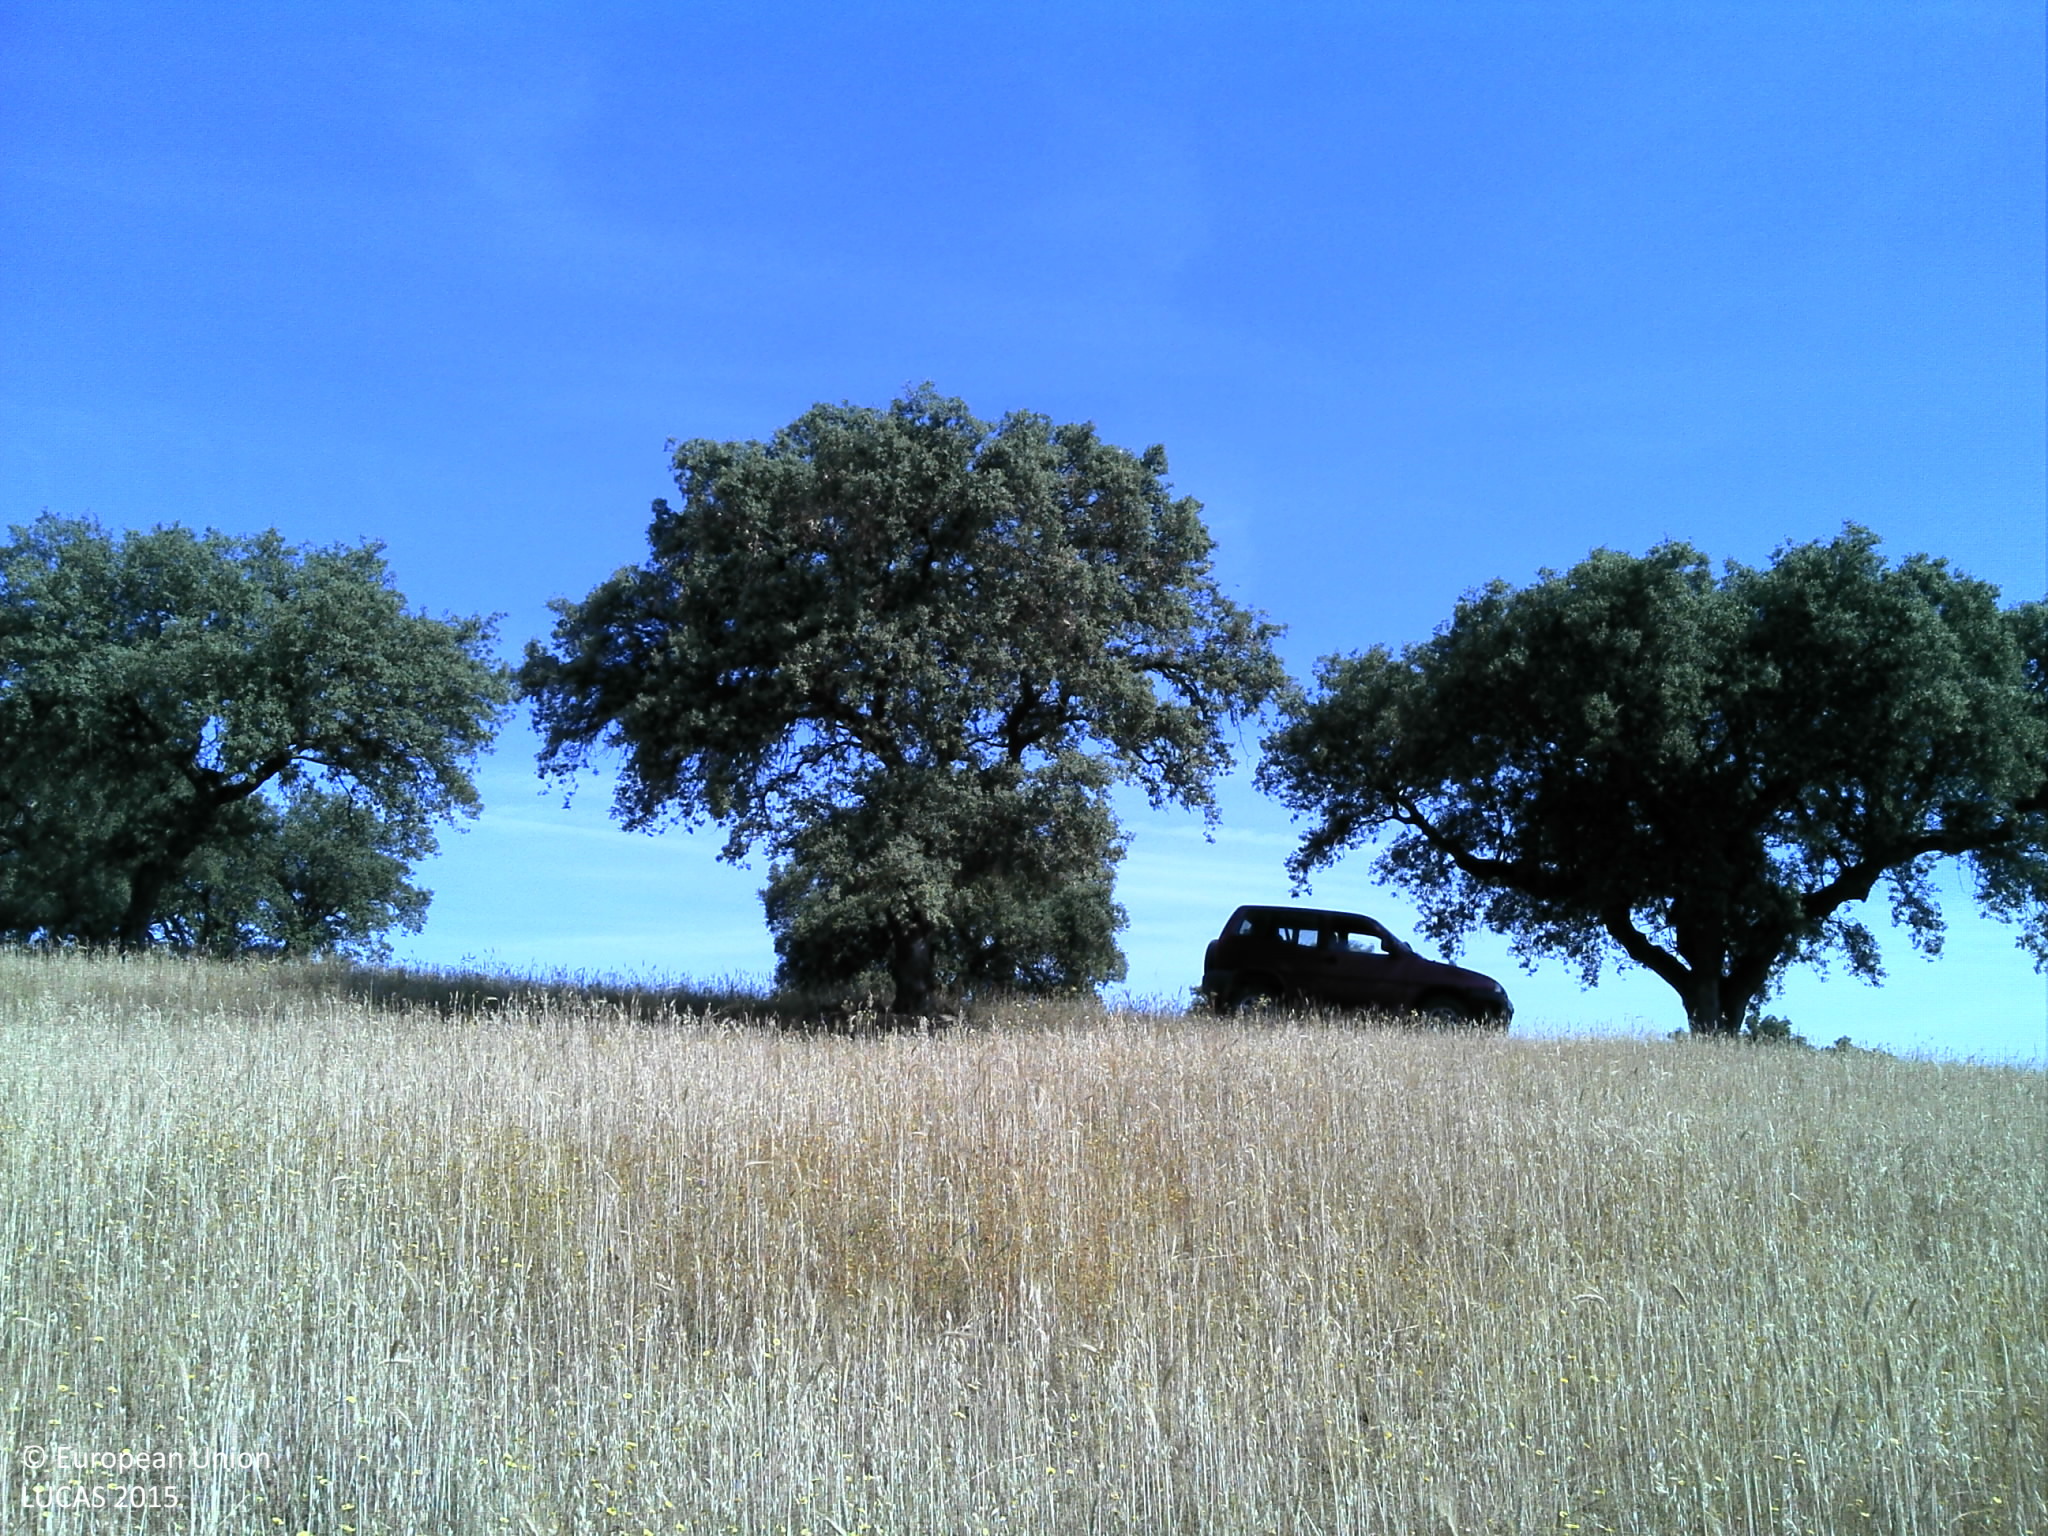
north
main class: Cropland
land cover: Olive groves
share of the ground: 10 - 25 %
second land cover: Triticale
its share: 10 - 25 %
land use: Agriculture (excluding fallow land and kitchen gardens)
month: May
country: PT
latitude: 39.0512
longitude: -7.5930
